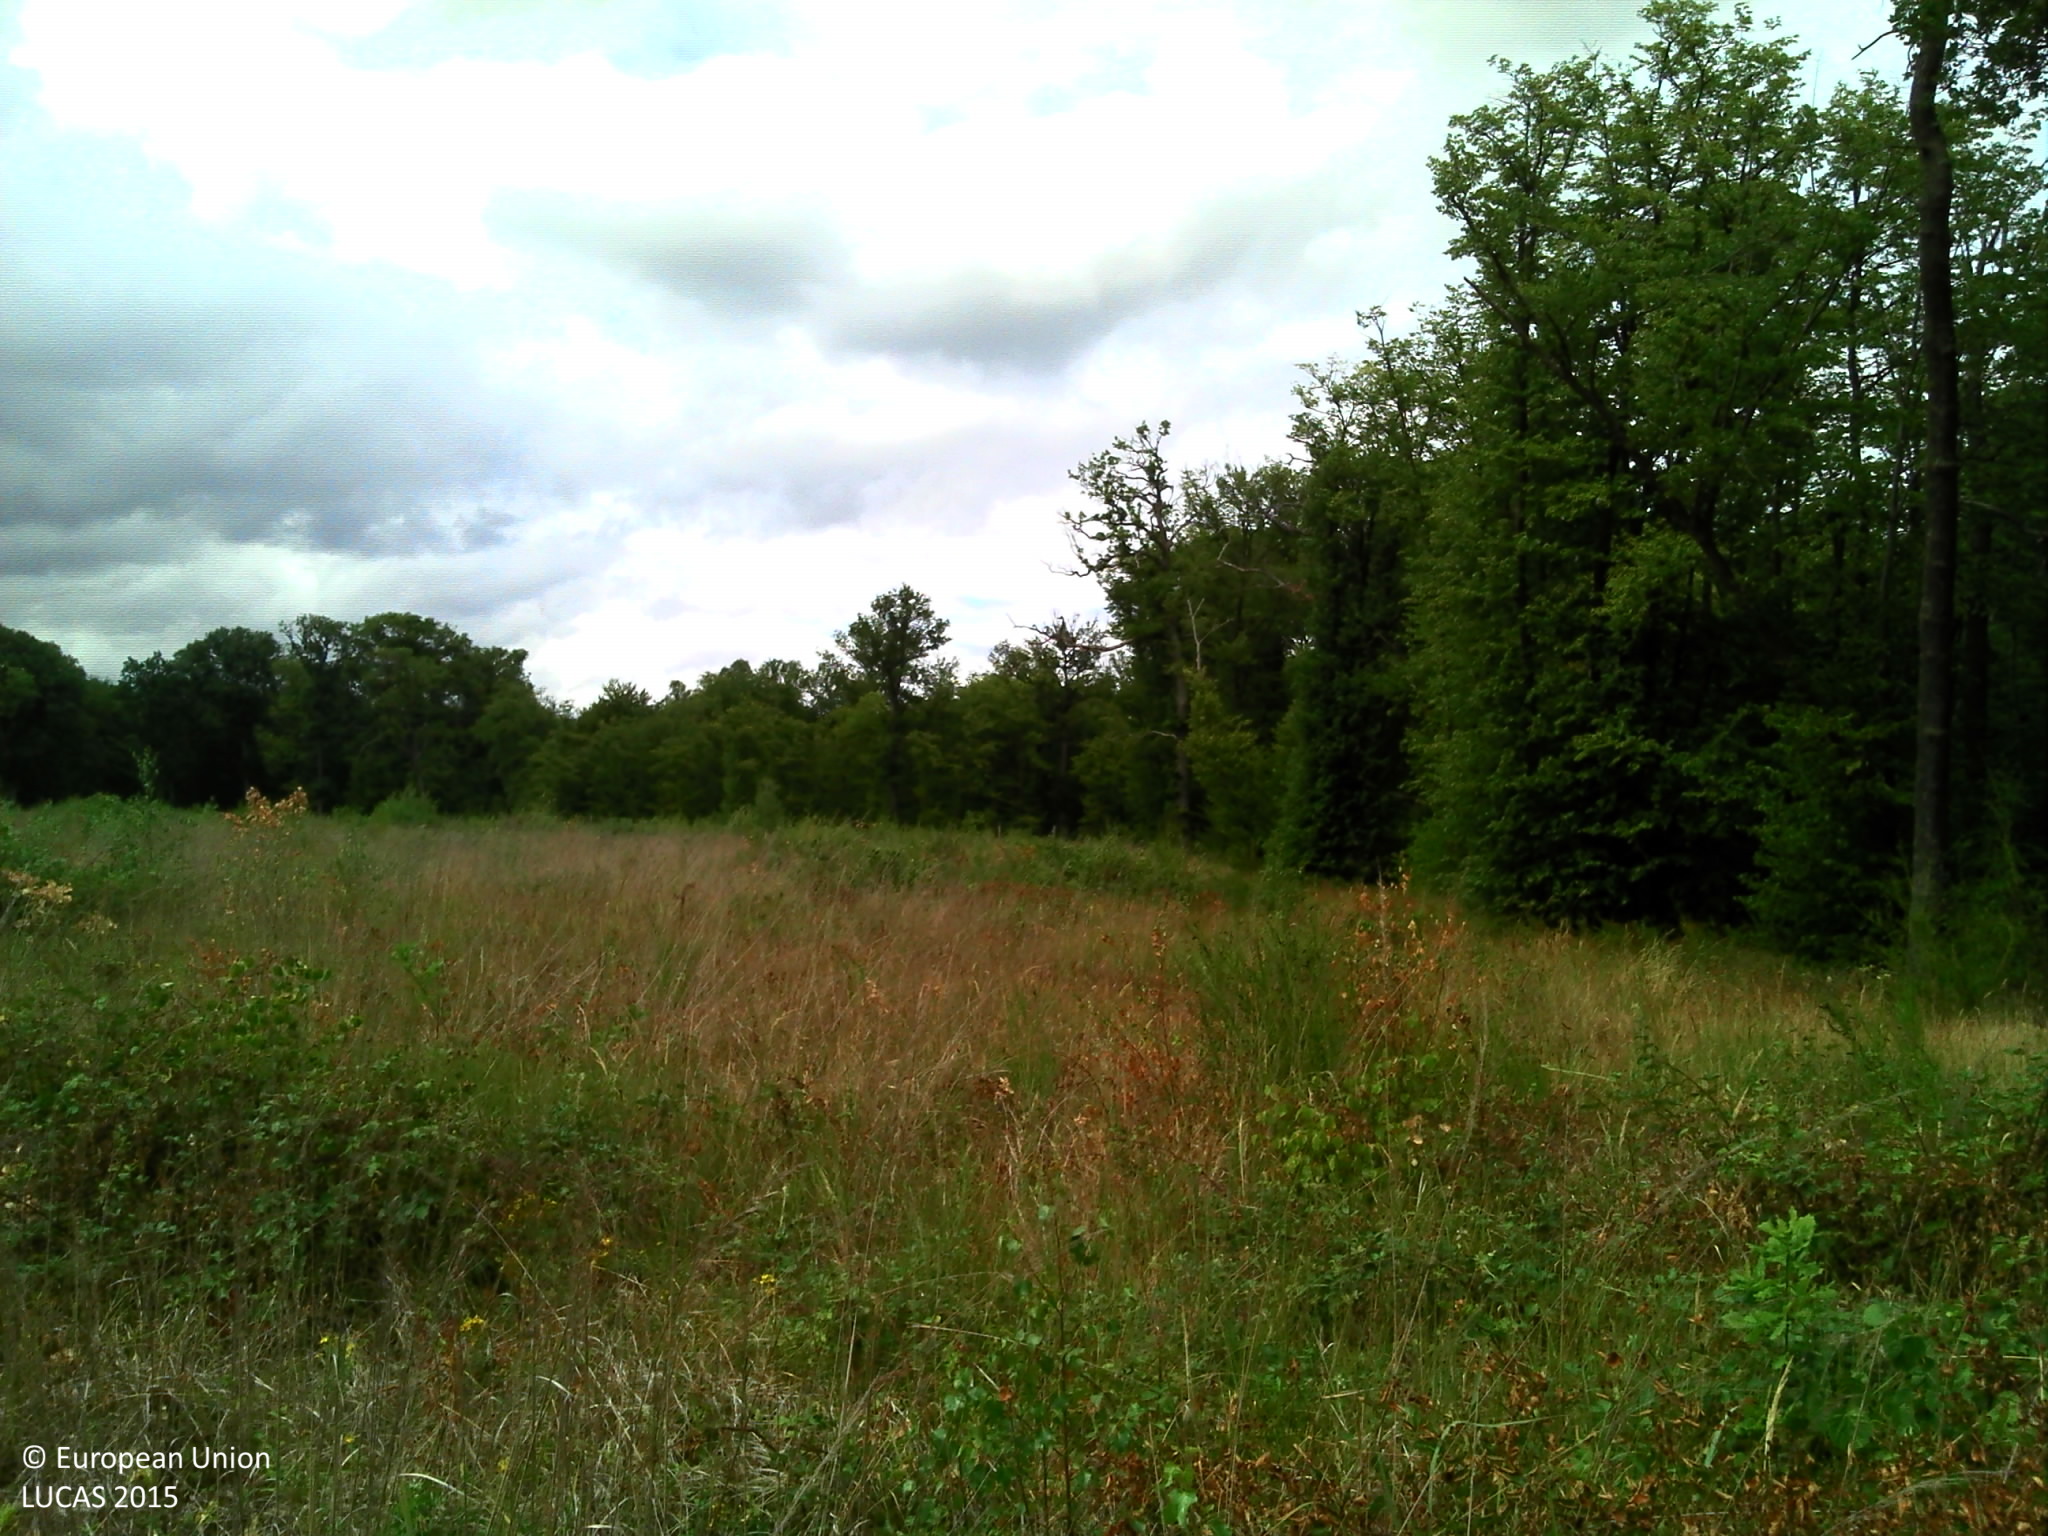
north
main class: Shrubland
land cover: Shrubland with sparse tree cover
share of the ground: > 75 %
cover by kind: shrubs 55 %, herbaceous plants 40 %, broadleaved forest trees 5 %
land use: Semi-natural and natural areas not in use
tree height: < 5 m
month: July
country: FR
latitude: 49.1416
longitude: 2.4901
